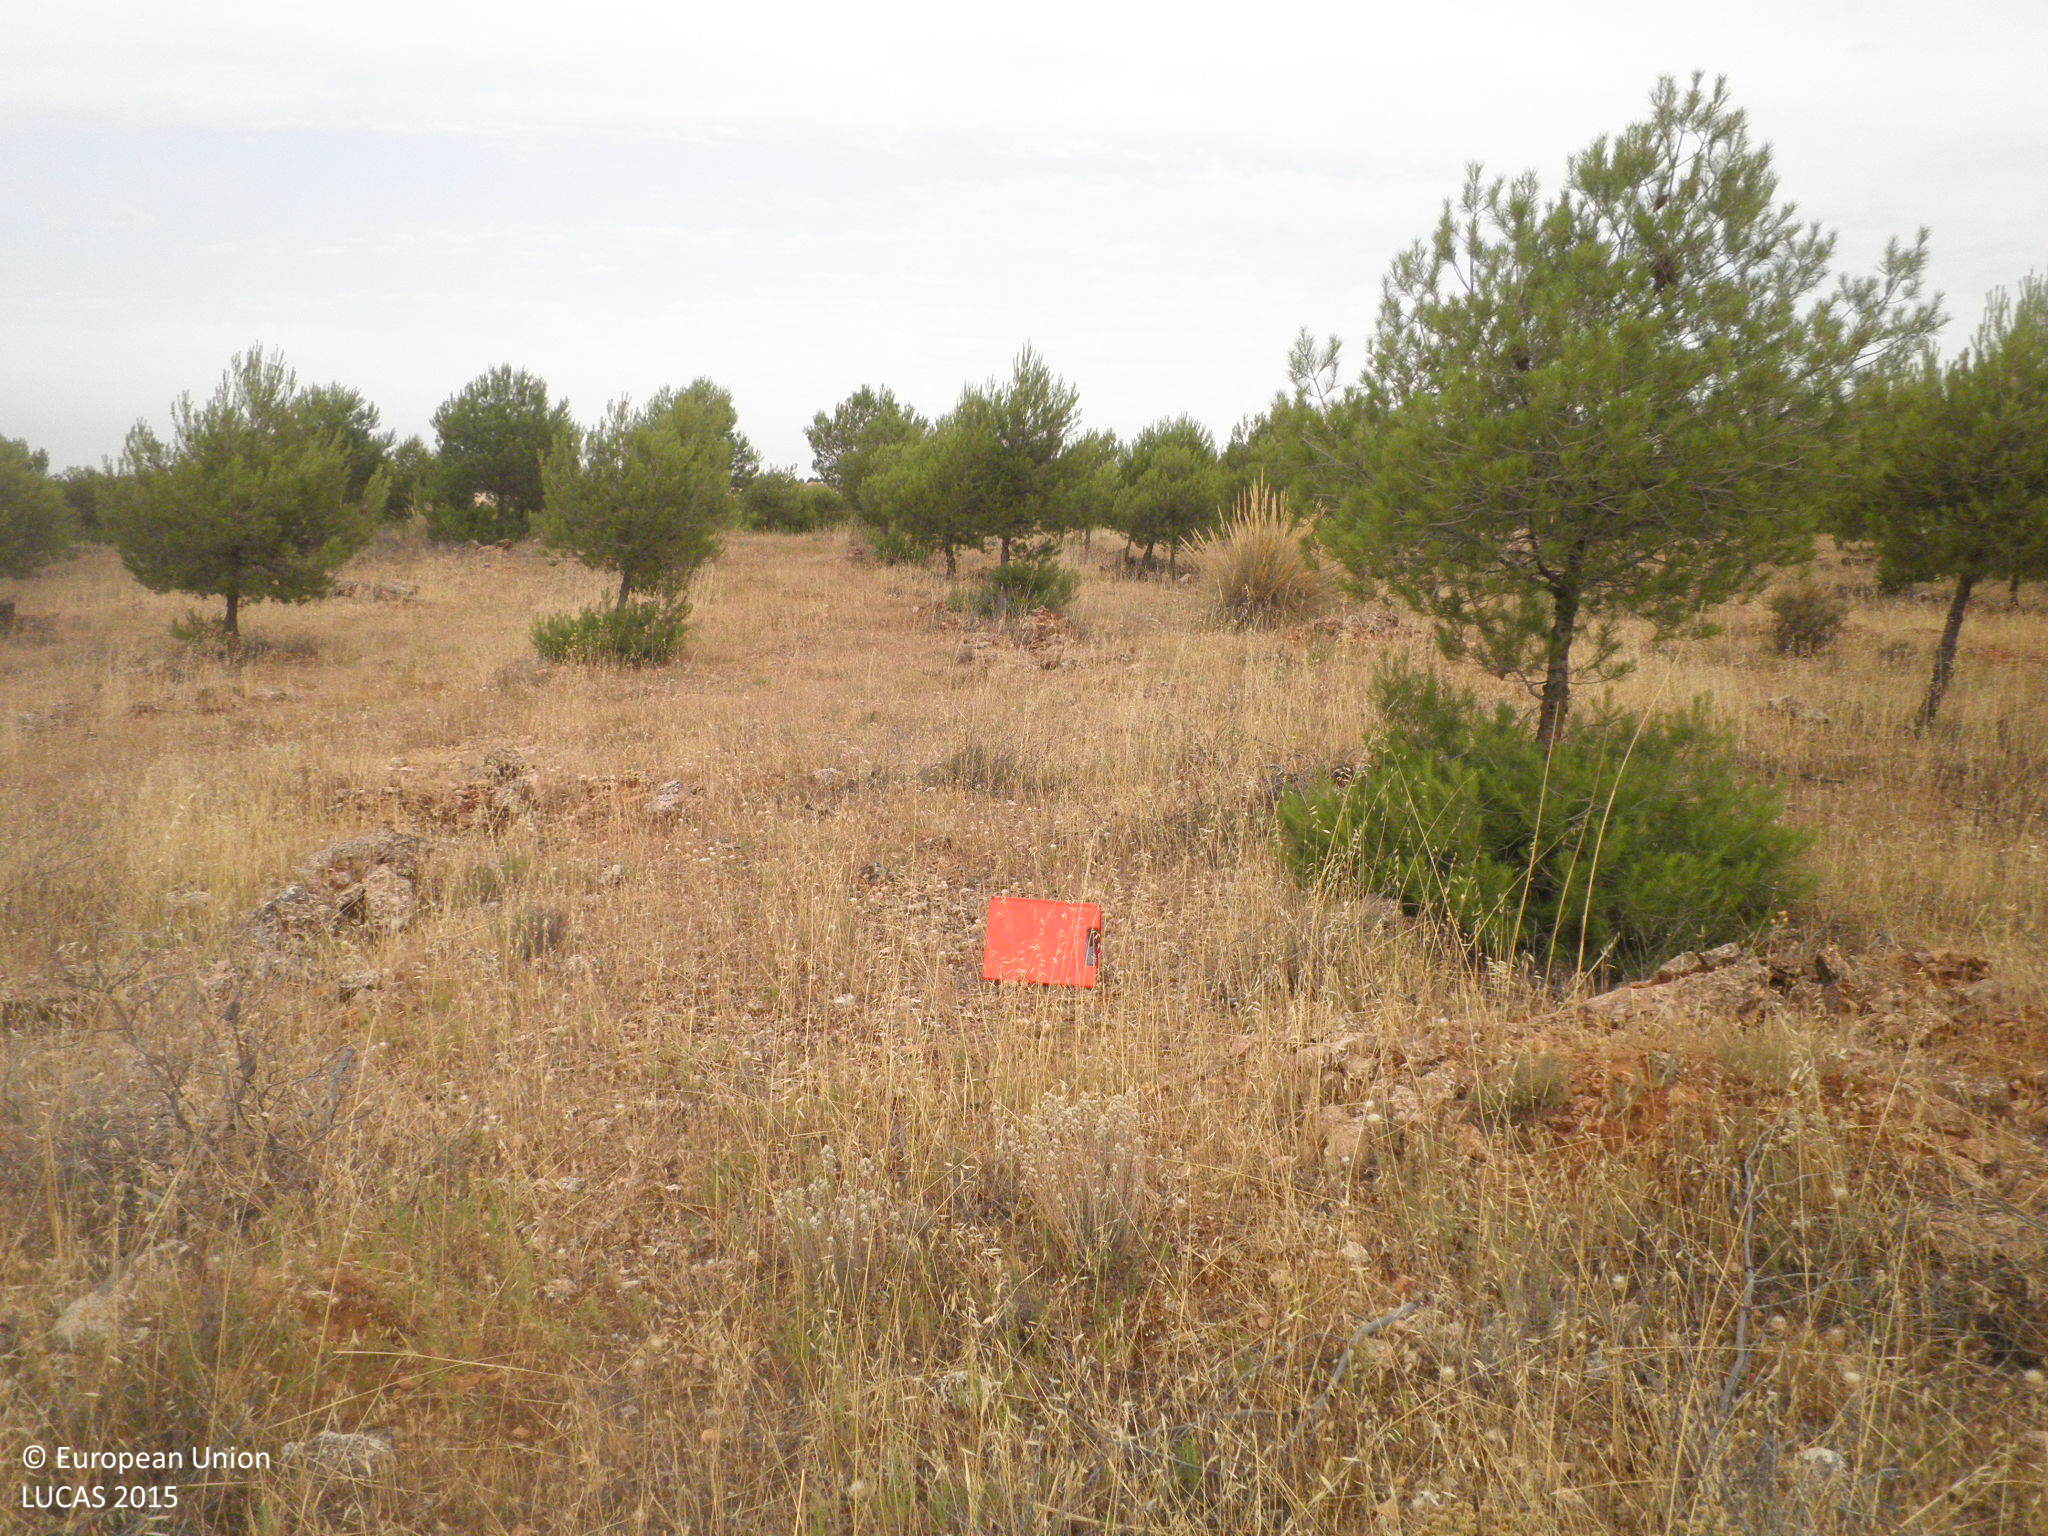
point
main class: Woodland
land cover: Pine dominated coniferous woodland
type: coniferous forest of the mediterranean region
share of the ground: 10 - 25 %
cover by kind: herbaceous plants 75 %, coniferous forest trees 10 %, consolidated bare surface 10 %, shrubs 5 %
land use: Semi-natural and natural areas not in use
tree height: < 5 m
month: July
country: ES
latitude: 39.4784
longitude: -2.6735
